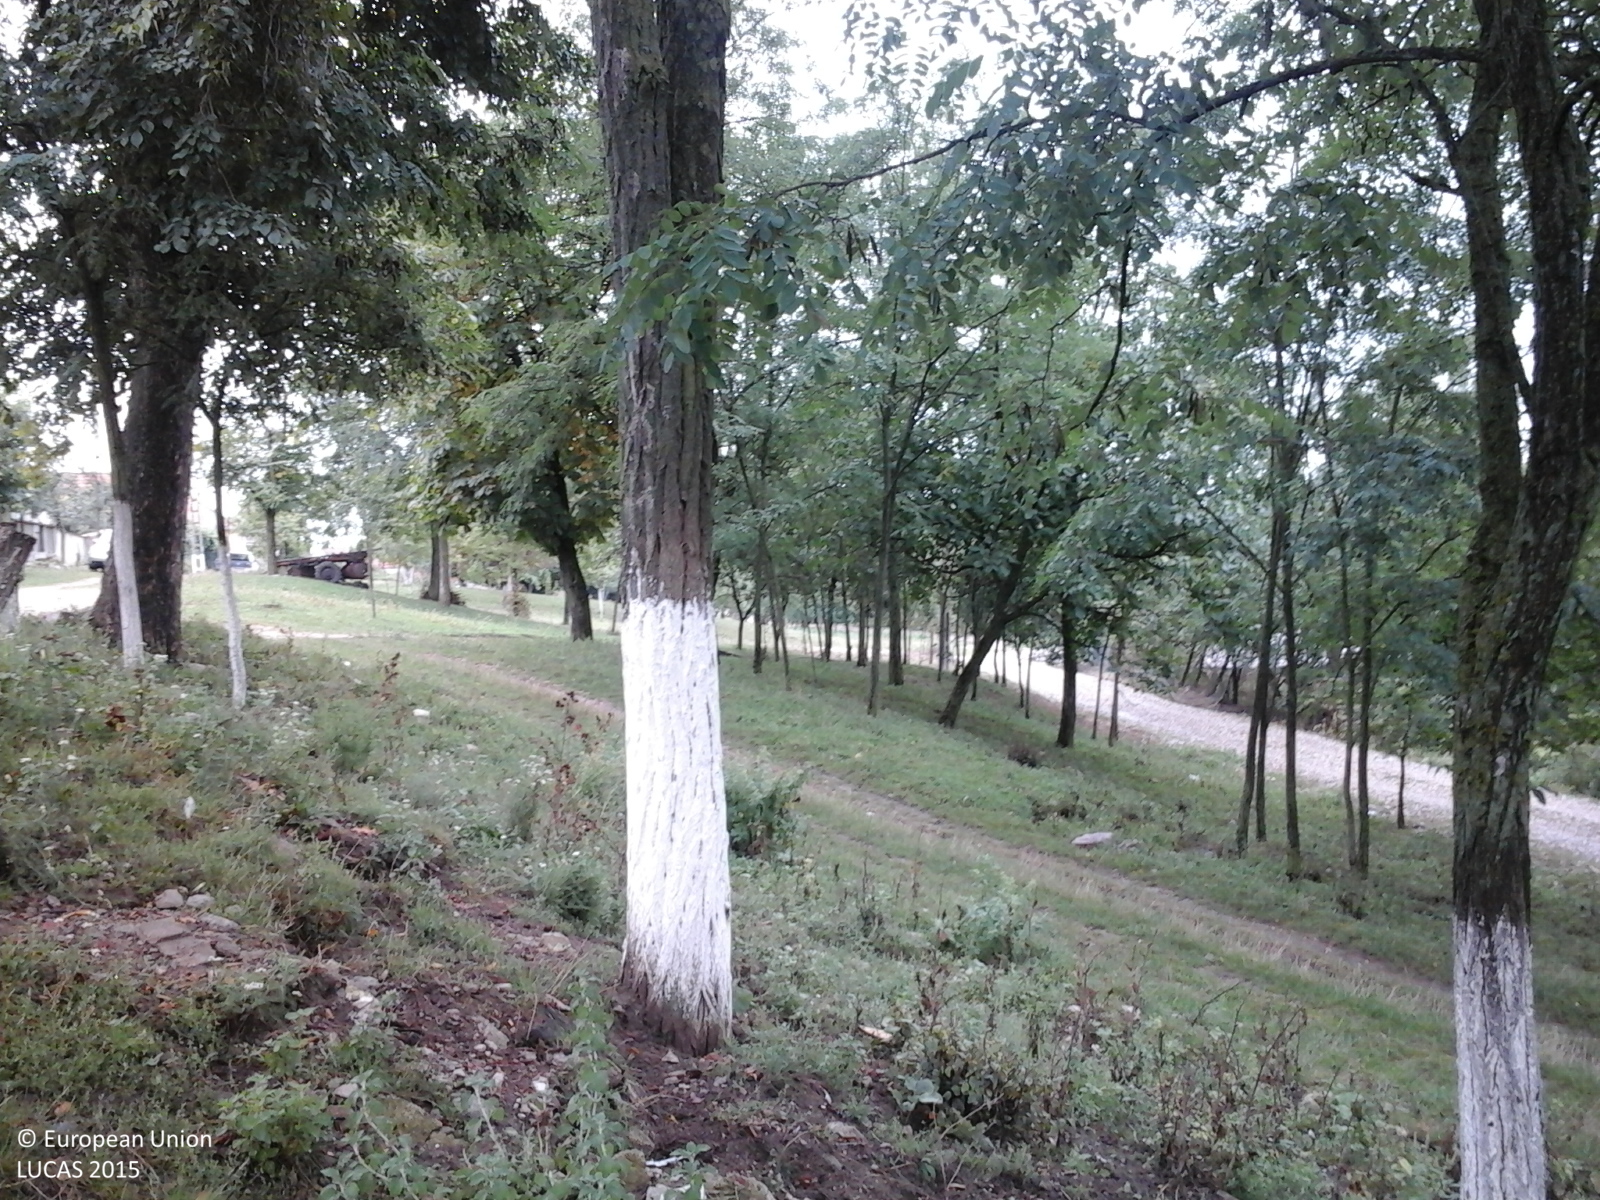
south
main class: Woodland
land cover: Broadleaved woodland
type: exotic forest
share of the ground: > 75 %
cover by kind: broadleaved forest trees 100 %
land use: Forestry
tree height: > 5 m
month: September
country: RO
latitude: 46.8411
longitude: 21.8053
